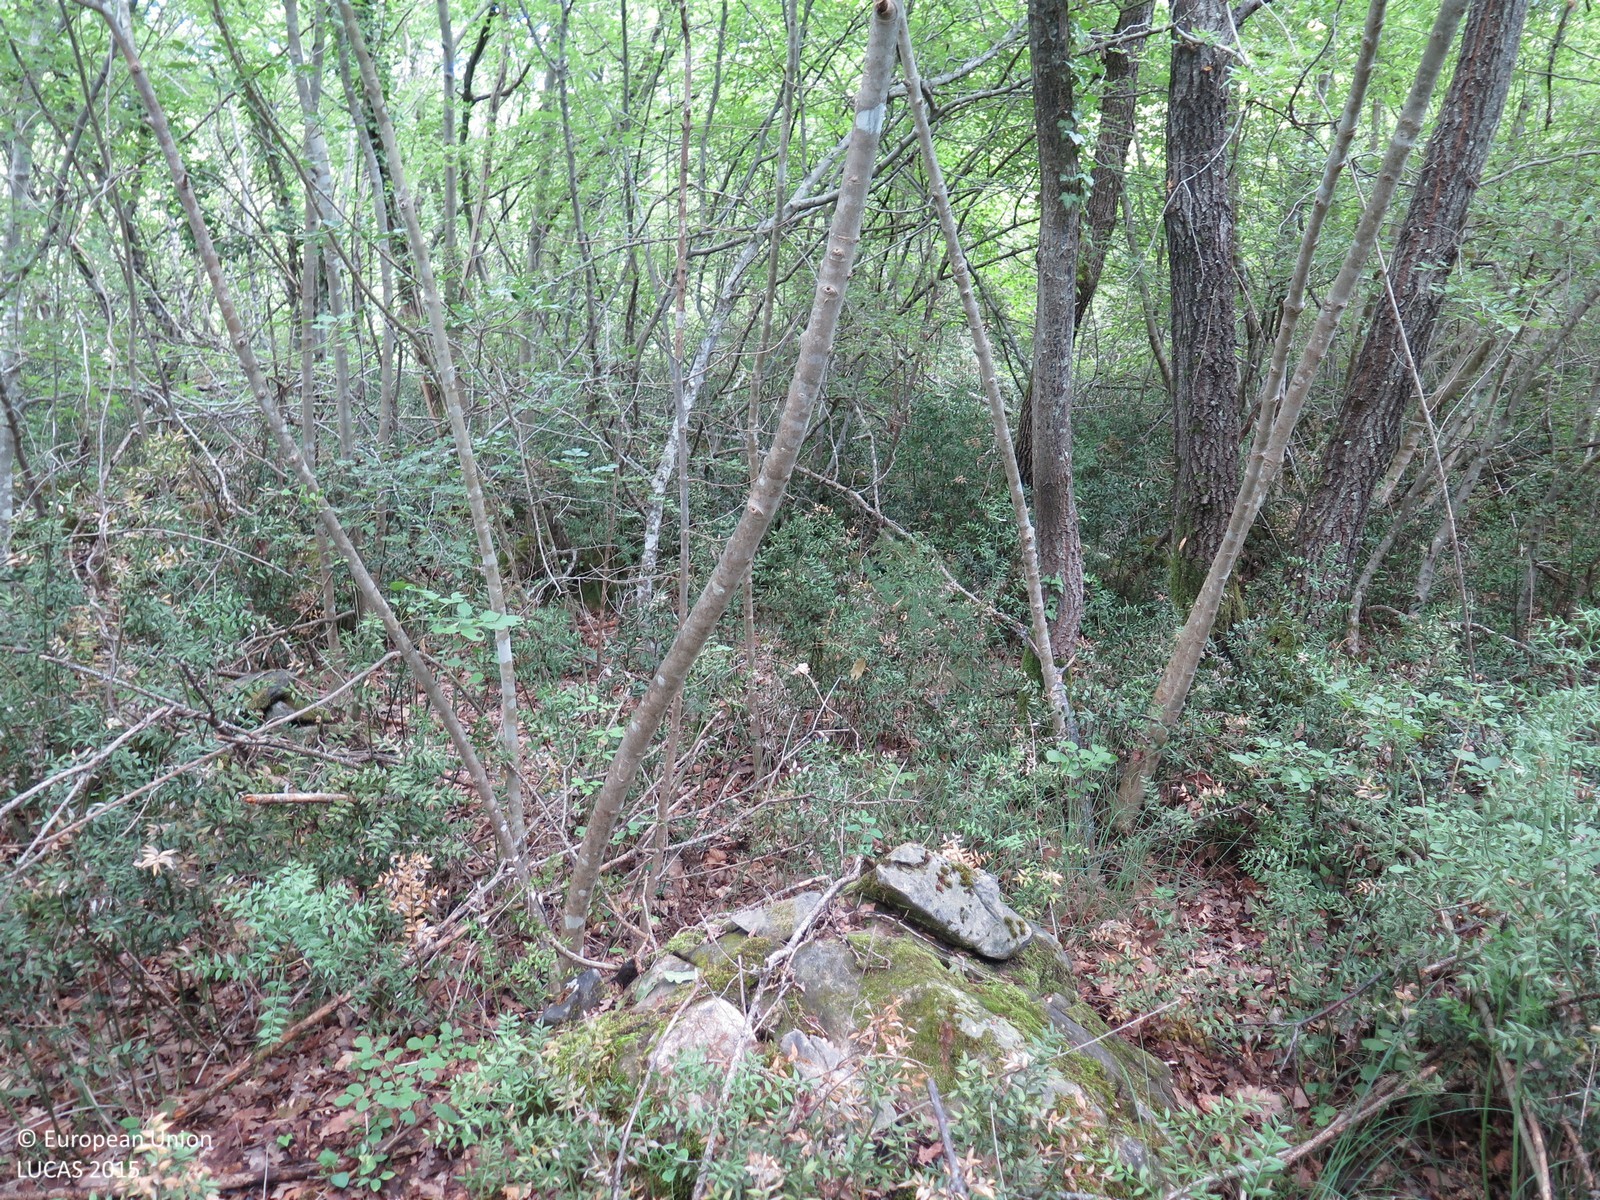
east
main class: Woodland
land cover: Broadleaved woodland
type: beech forest
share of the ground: > 75 %
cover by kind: broadleaved forest trees 95 %, shrubs 5 %
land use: Semi-natural and natural areas not in use
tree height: > 5 m
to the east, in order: Broadleaved woodland; Tracks; Electric lines; Broadleaved woodland; Tracks; Broadleaved woodland; Tracks; Broadleaved woodland
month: June
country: HR
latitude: 45.2428
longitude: 13.6512
